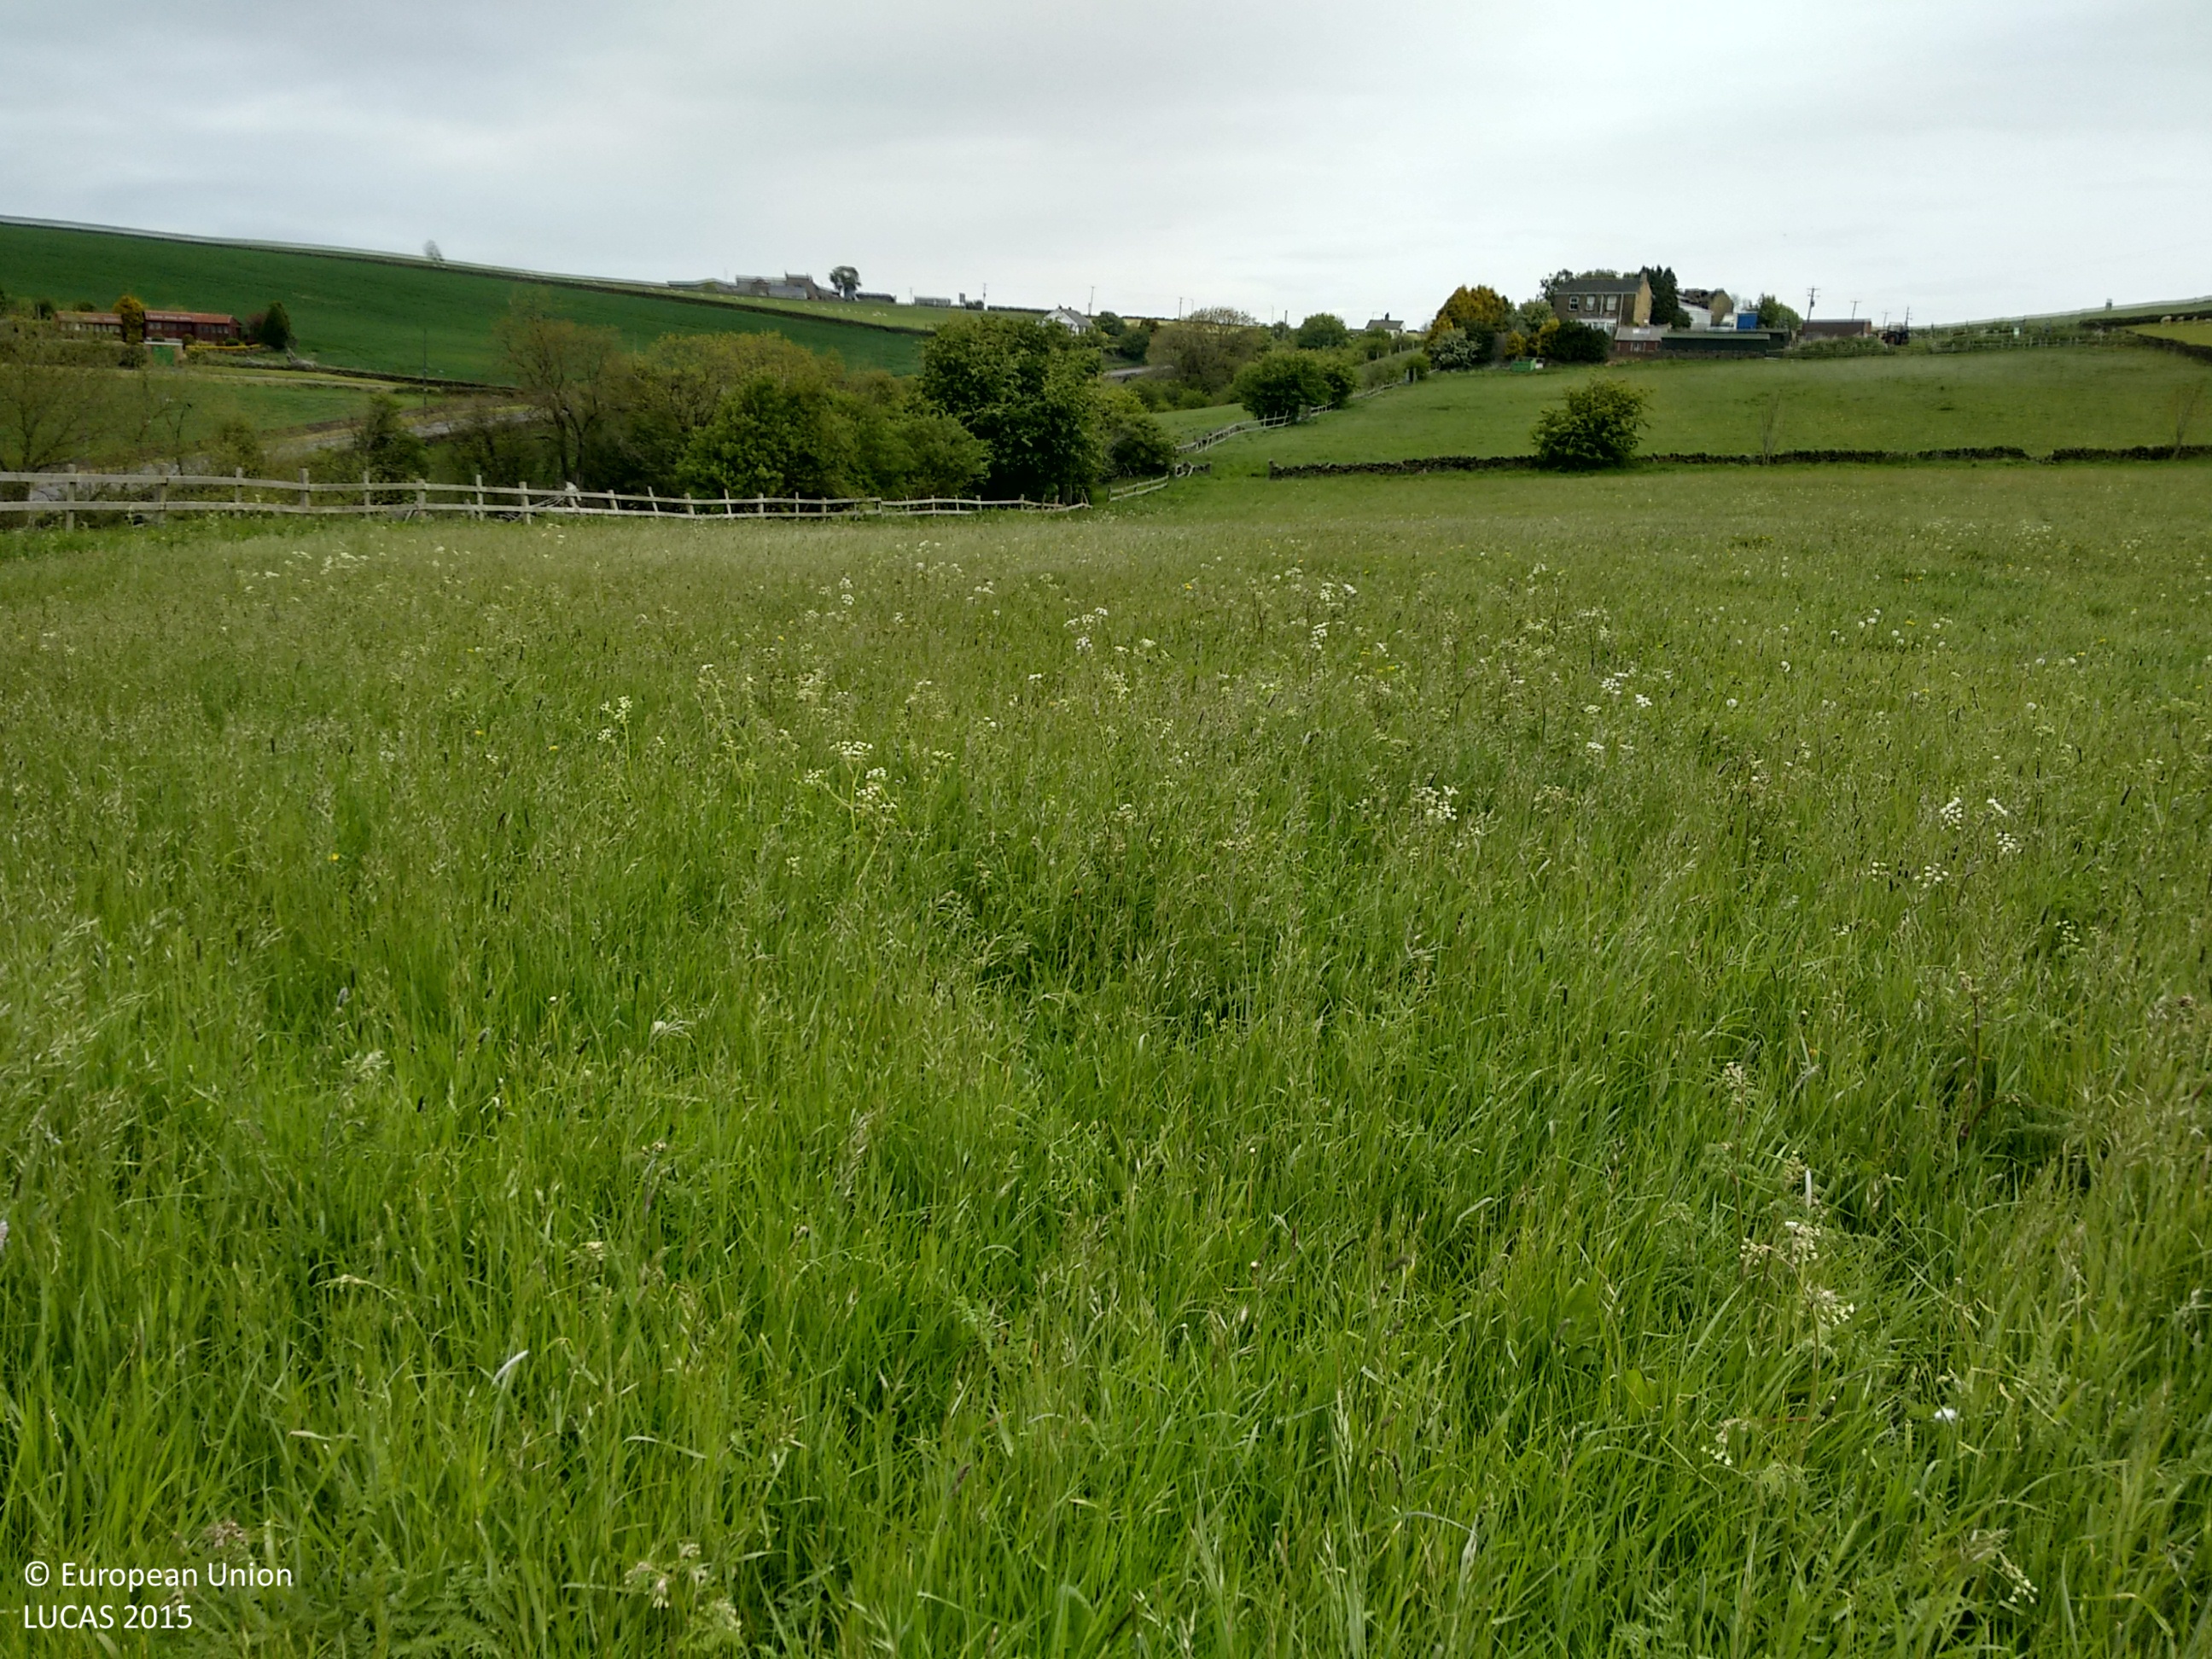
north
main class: Grassland
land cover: Grassland without tree/shrub cover
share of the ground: > 75 %
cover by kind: herbaceous plants 100 %
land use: Agriculture (excluding fallow land and kitchen gardens)
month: May
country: GB
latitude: 53.5157
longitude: -1.5883
